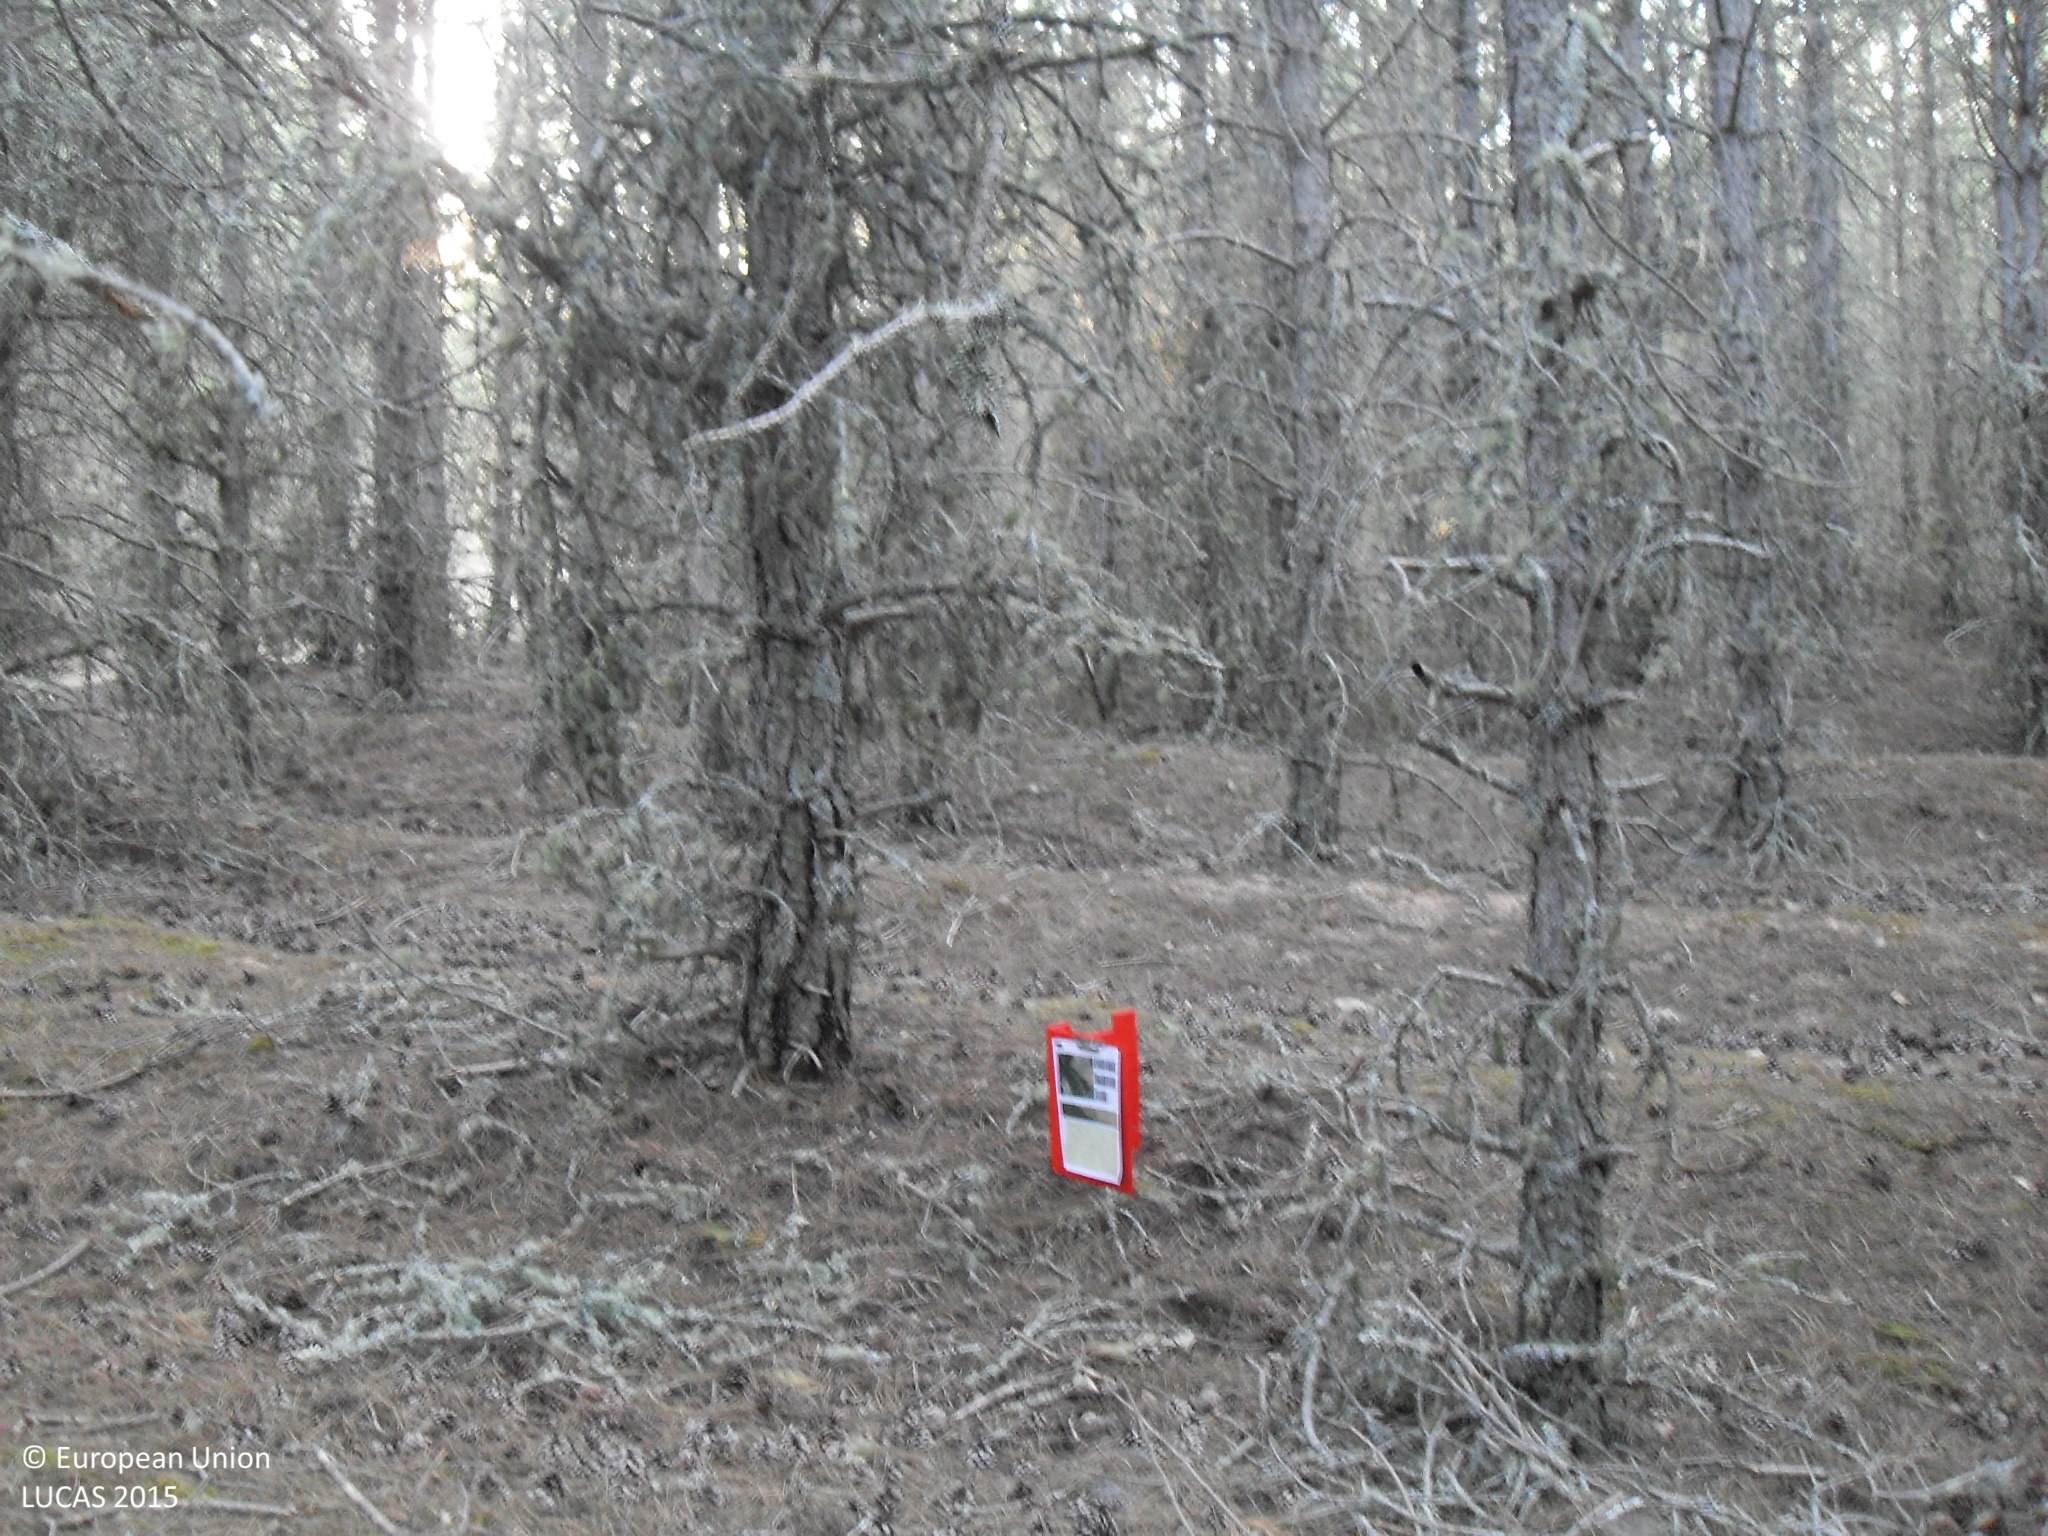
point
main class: Woodland
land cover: Pine dominated coniferous woodland
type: coniferous forest of the mediterranean region
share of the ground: > 75 %
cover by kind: coniferous forest trees 95 %, herbaceous plants 5 %
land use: Forestry
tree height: > 5 m
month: May
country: ES
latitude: 40.5747
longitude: -5.2433
